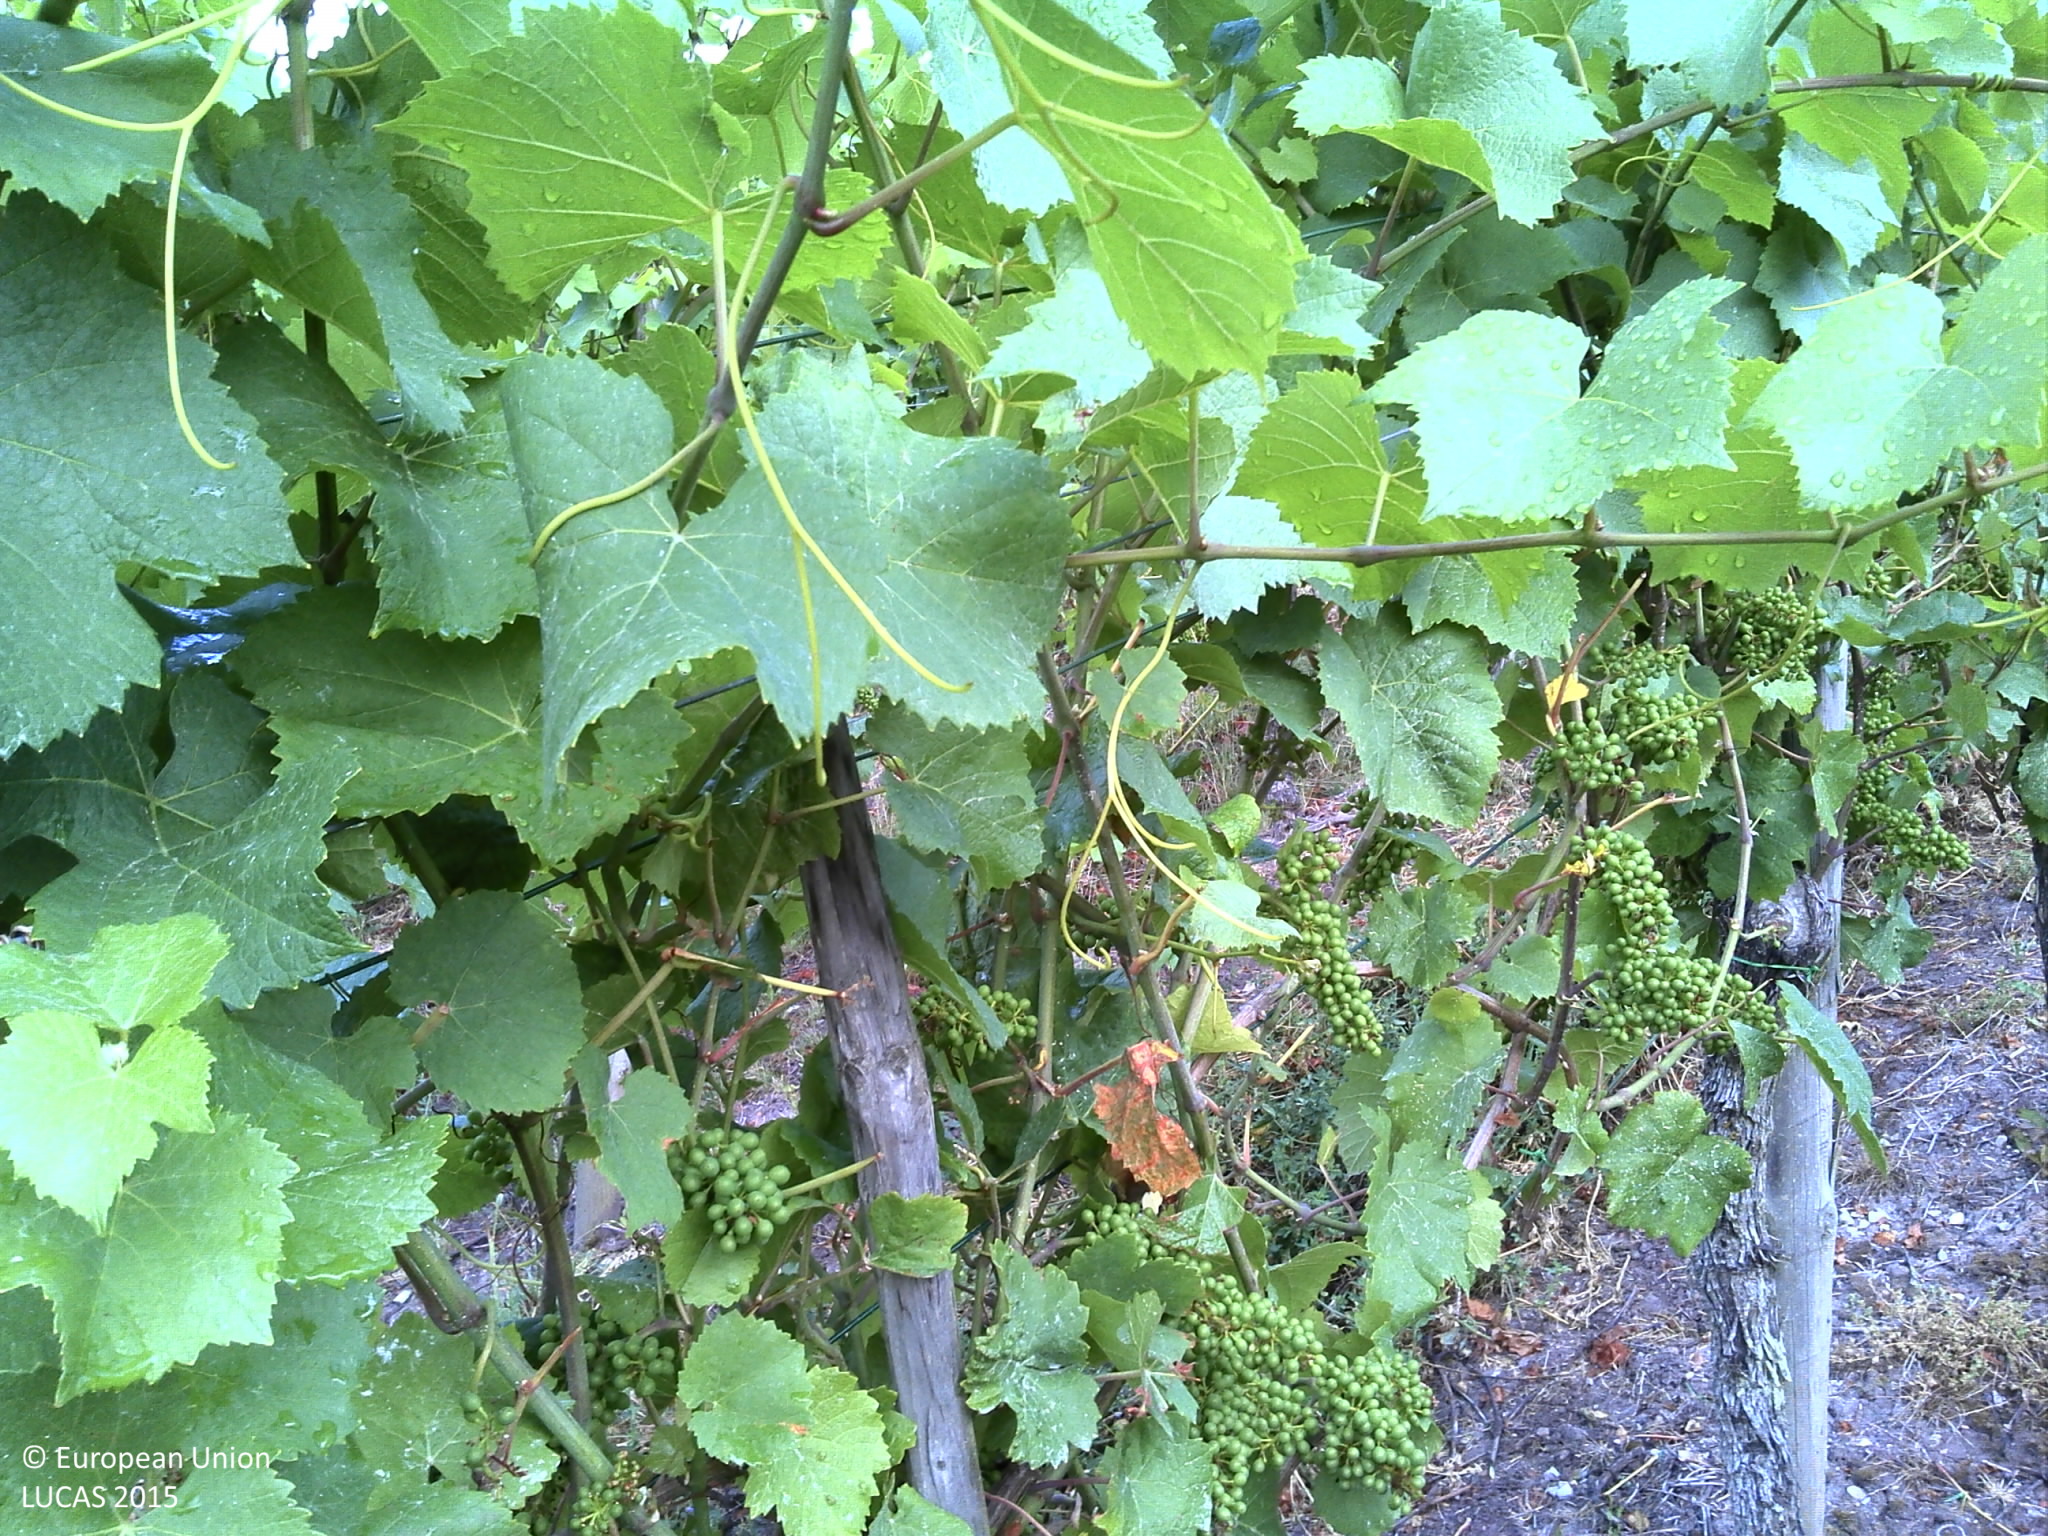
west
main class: Cropland
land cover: Vineyards
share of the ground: 50 - 75 %
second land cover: Grassland without tree/shrub cover
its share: 50 - 75 %
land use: Agriculture (excluding fallow land and kitchen gardens)
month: July
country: LU
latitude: 49.5314
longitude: 6.3382
